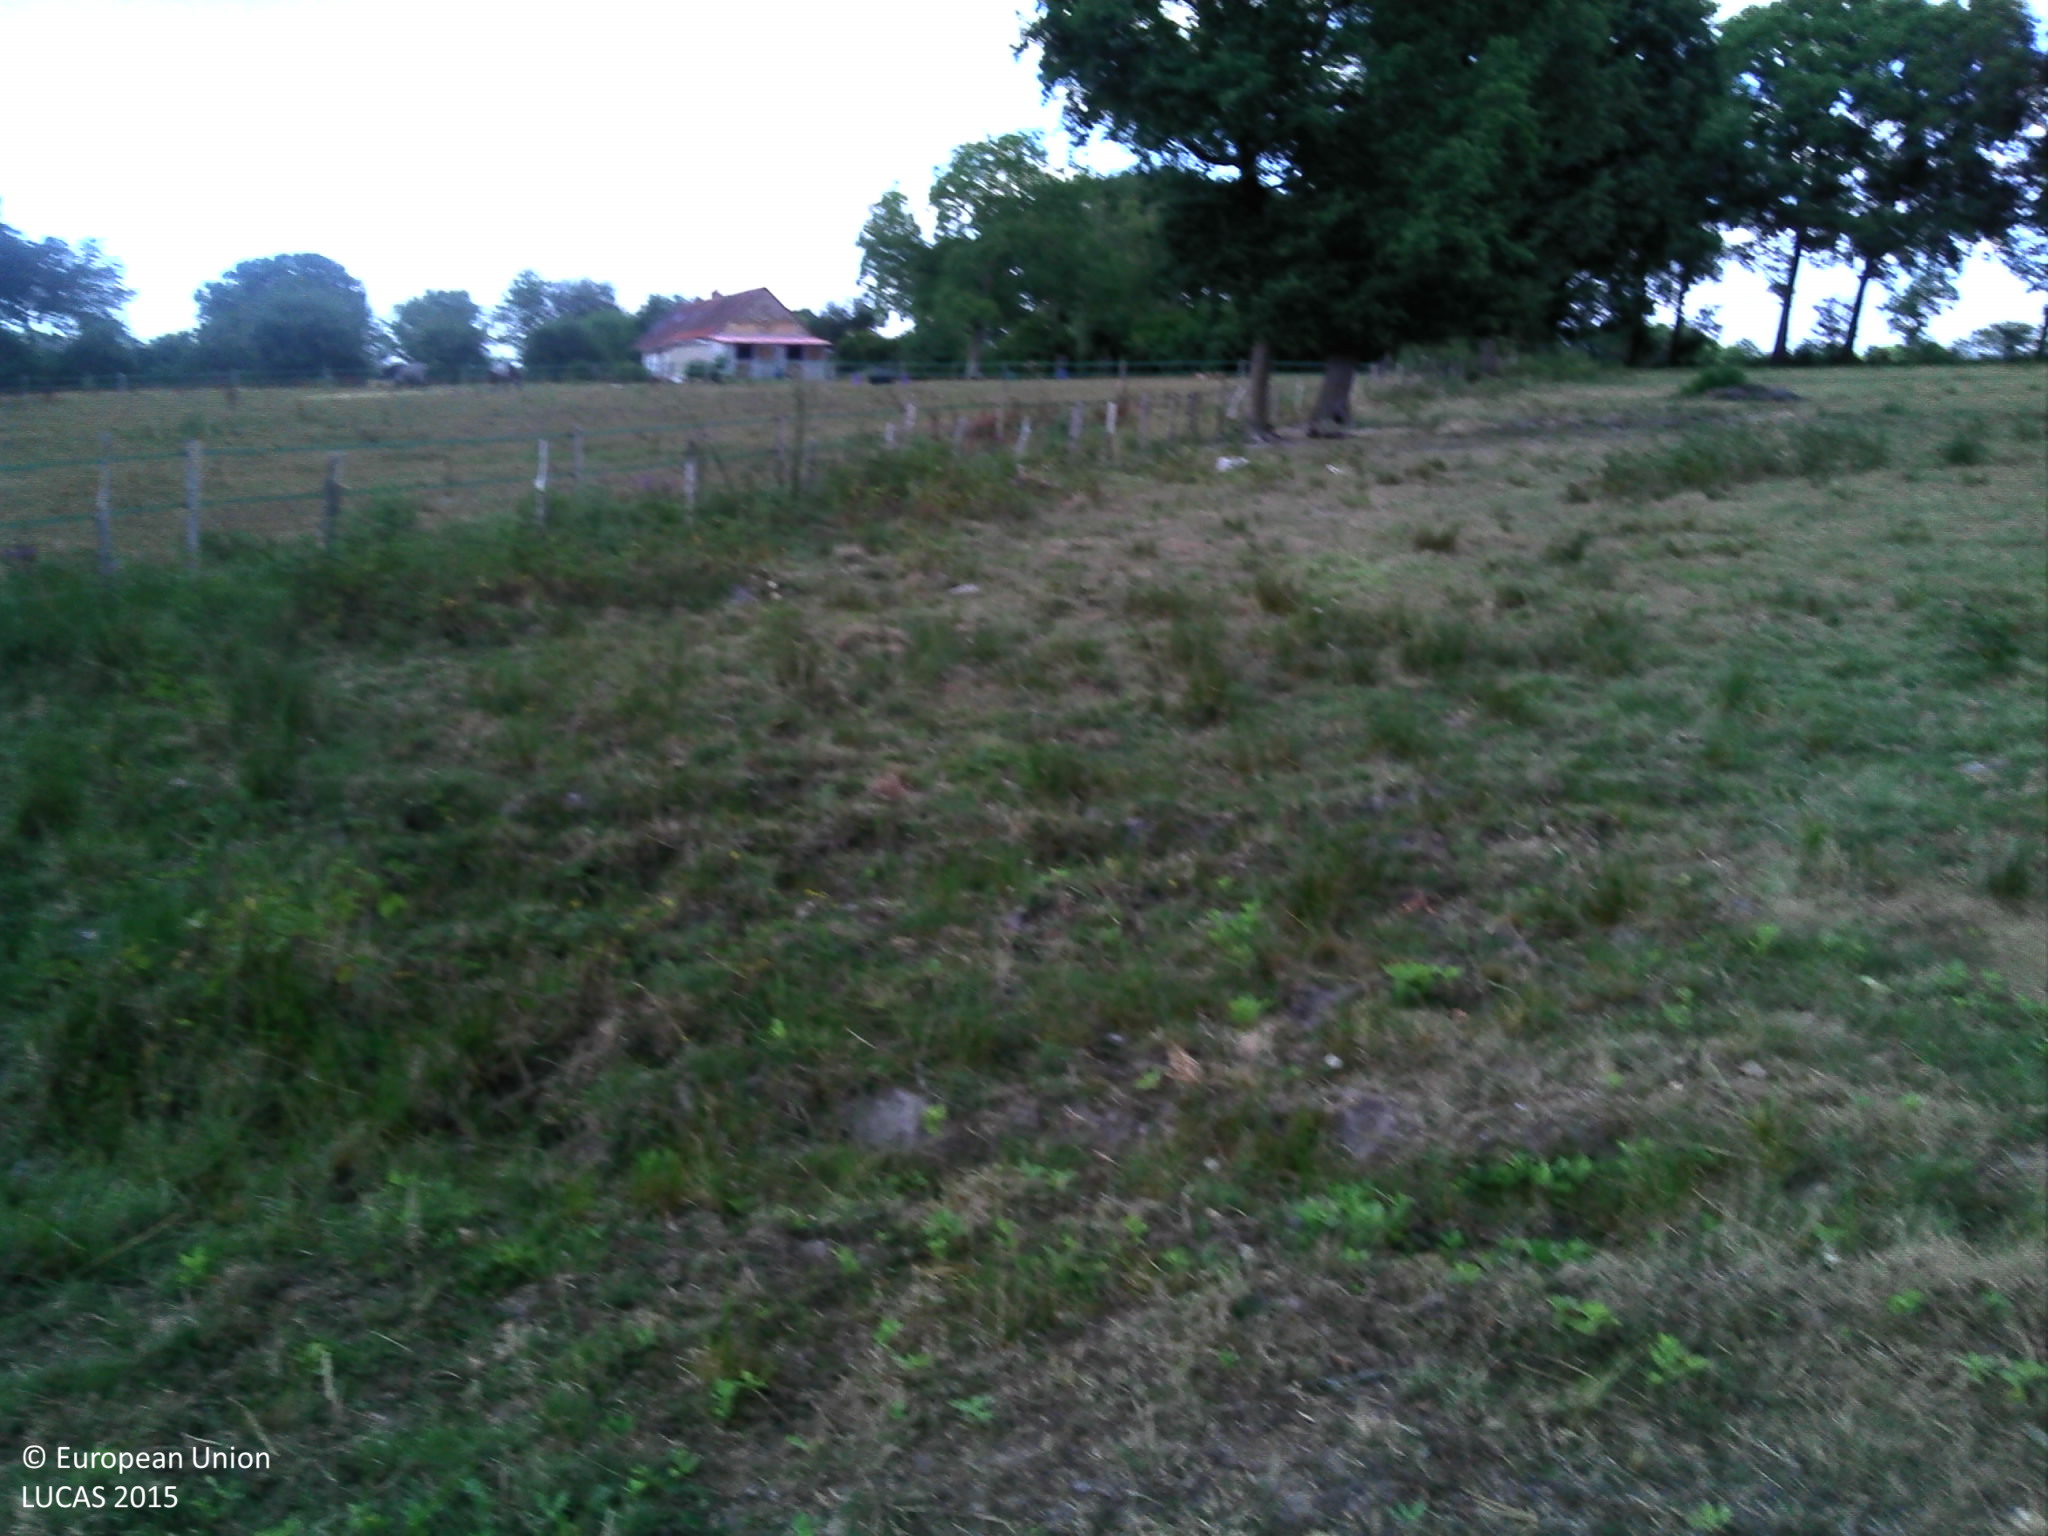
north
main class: Grassland
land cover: Grassland without tree/shrub cover
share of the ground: > 75 %
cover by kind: herbaceous plants 100 %
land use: Agriculture (excluding fallow land and kitchen gardens)
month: July
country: FR
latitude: 46.5625
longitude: 2.3103
